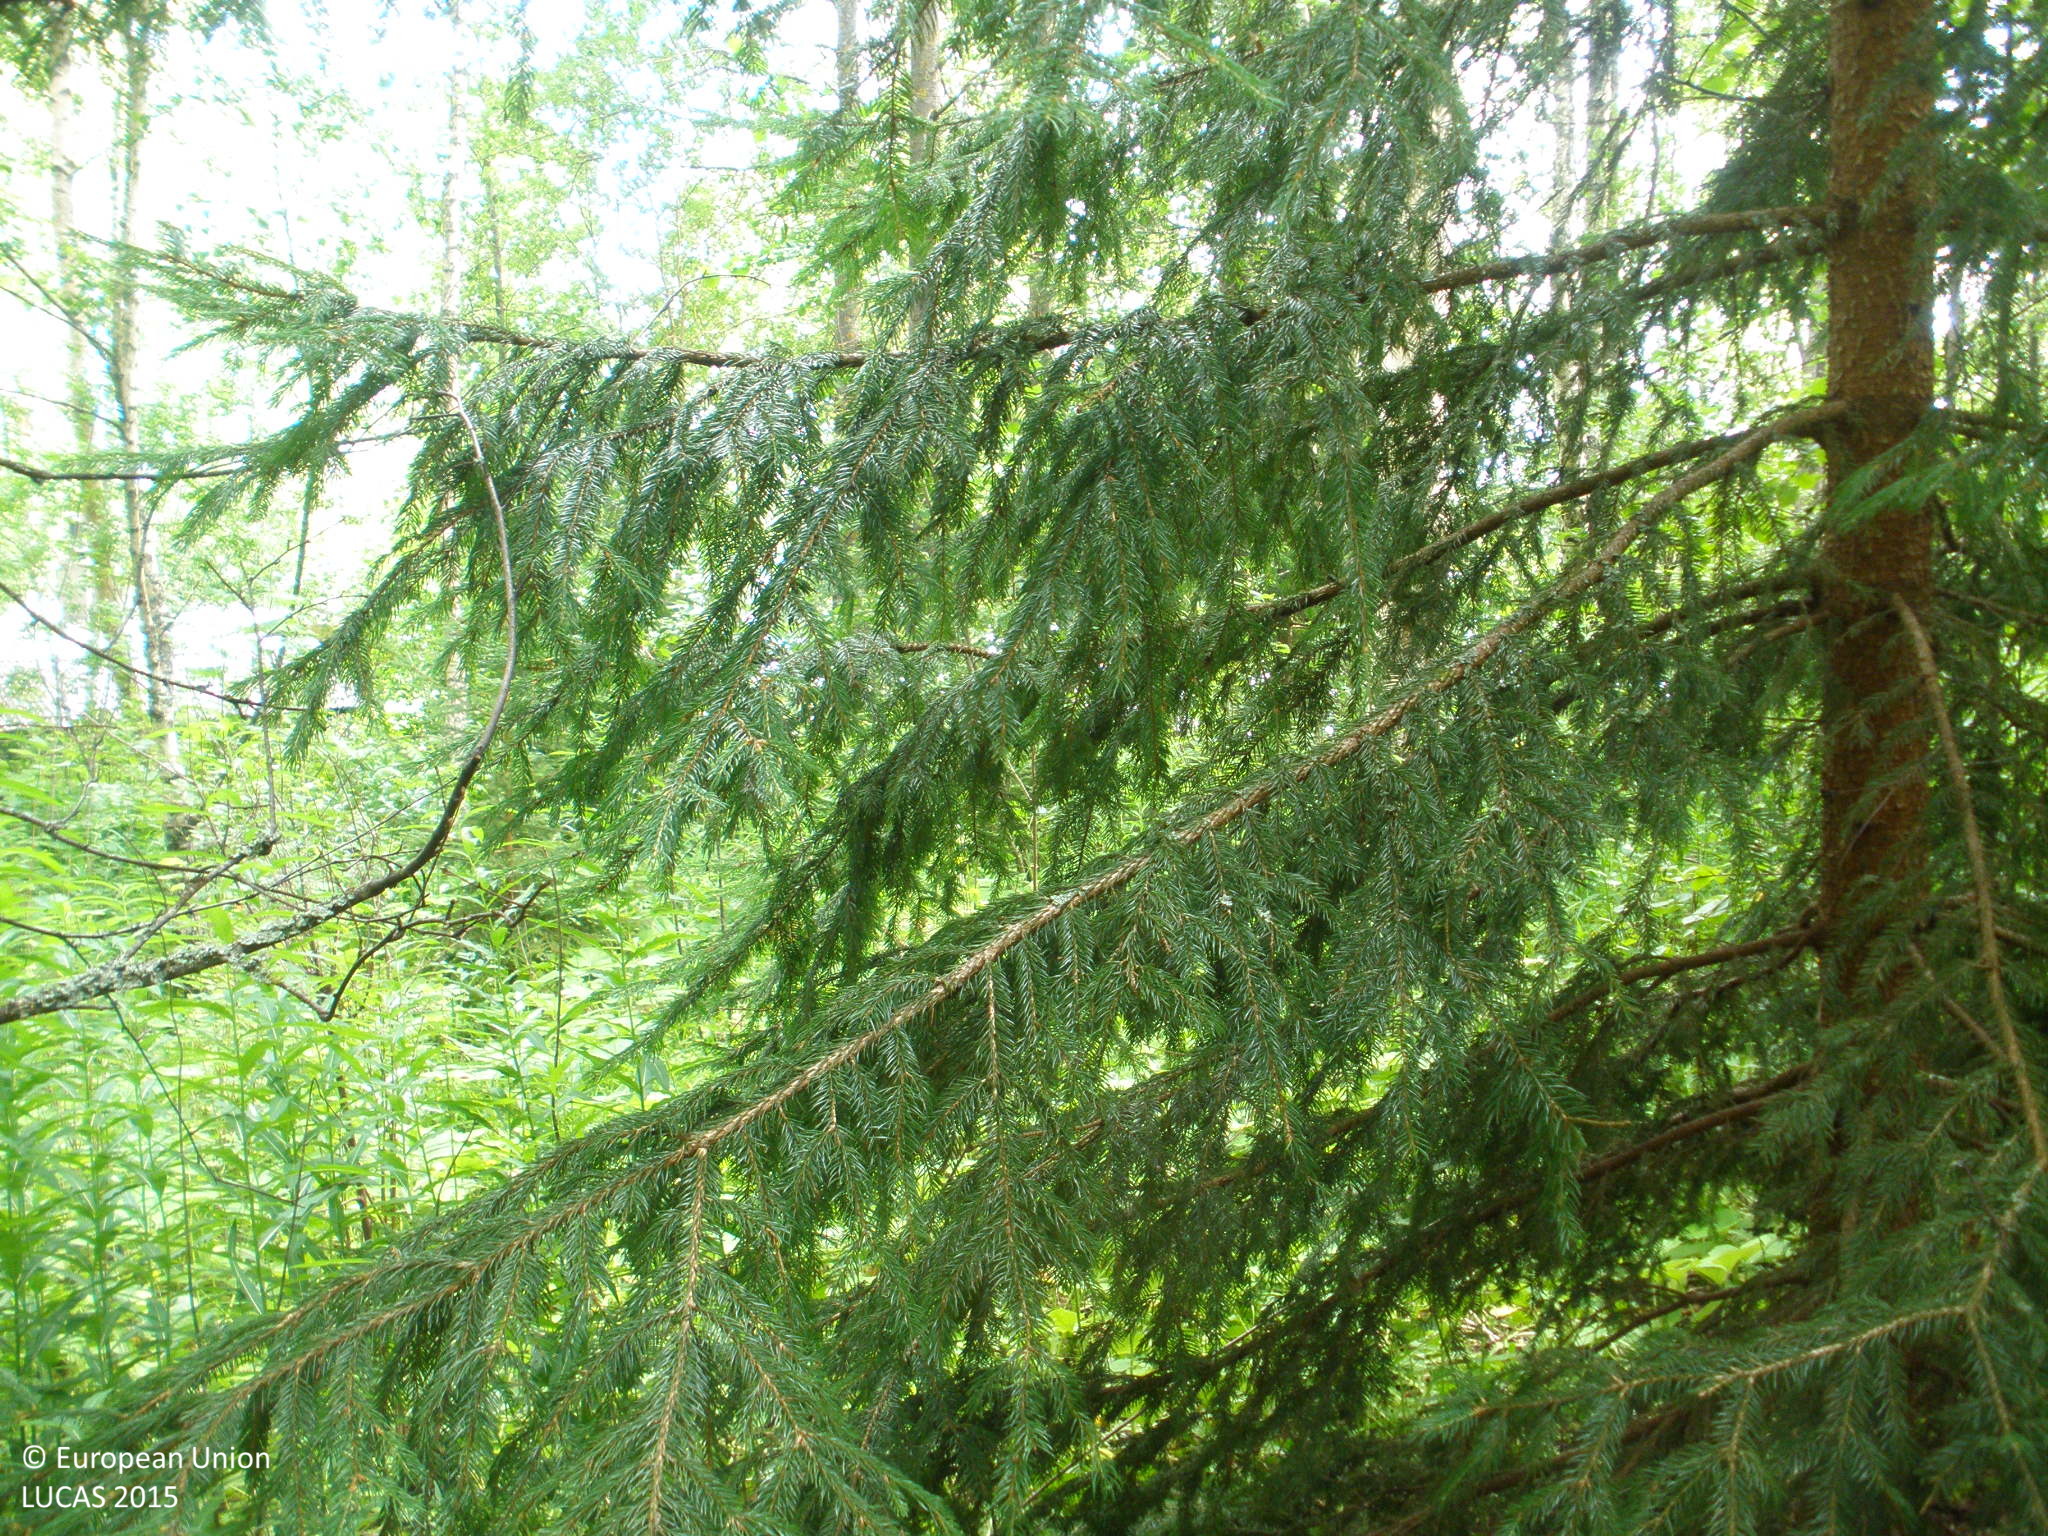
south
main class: Woodland
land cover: Spruce dominated mixed woodland
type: boreal forest
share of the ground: > 75 %
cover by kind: broadleaved forest trees 50 %, coniferous forest trees 25 %, herbaceous plants 20 %, shrubs 5 %
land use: Forestry
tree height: > 5 m
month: July
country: FI
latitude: 60.9520
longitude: 24.1083
